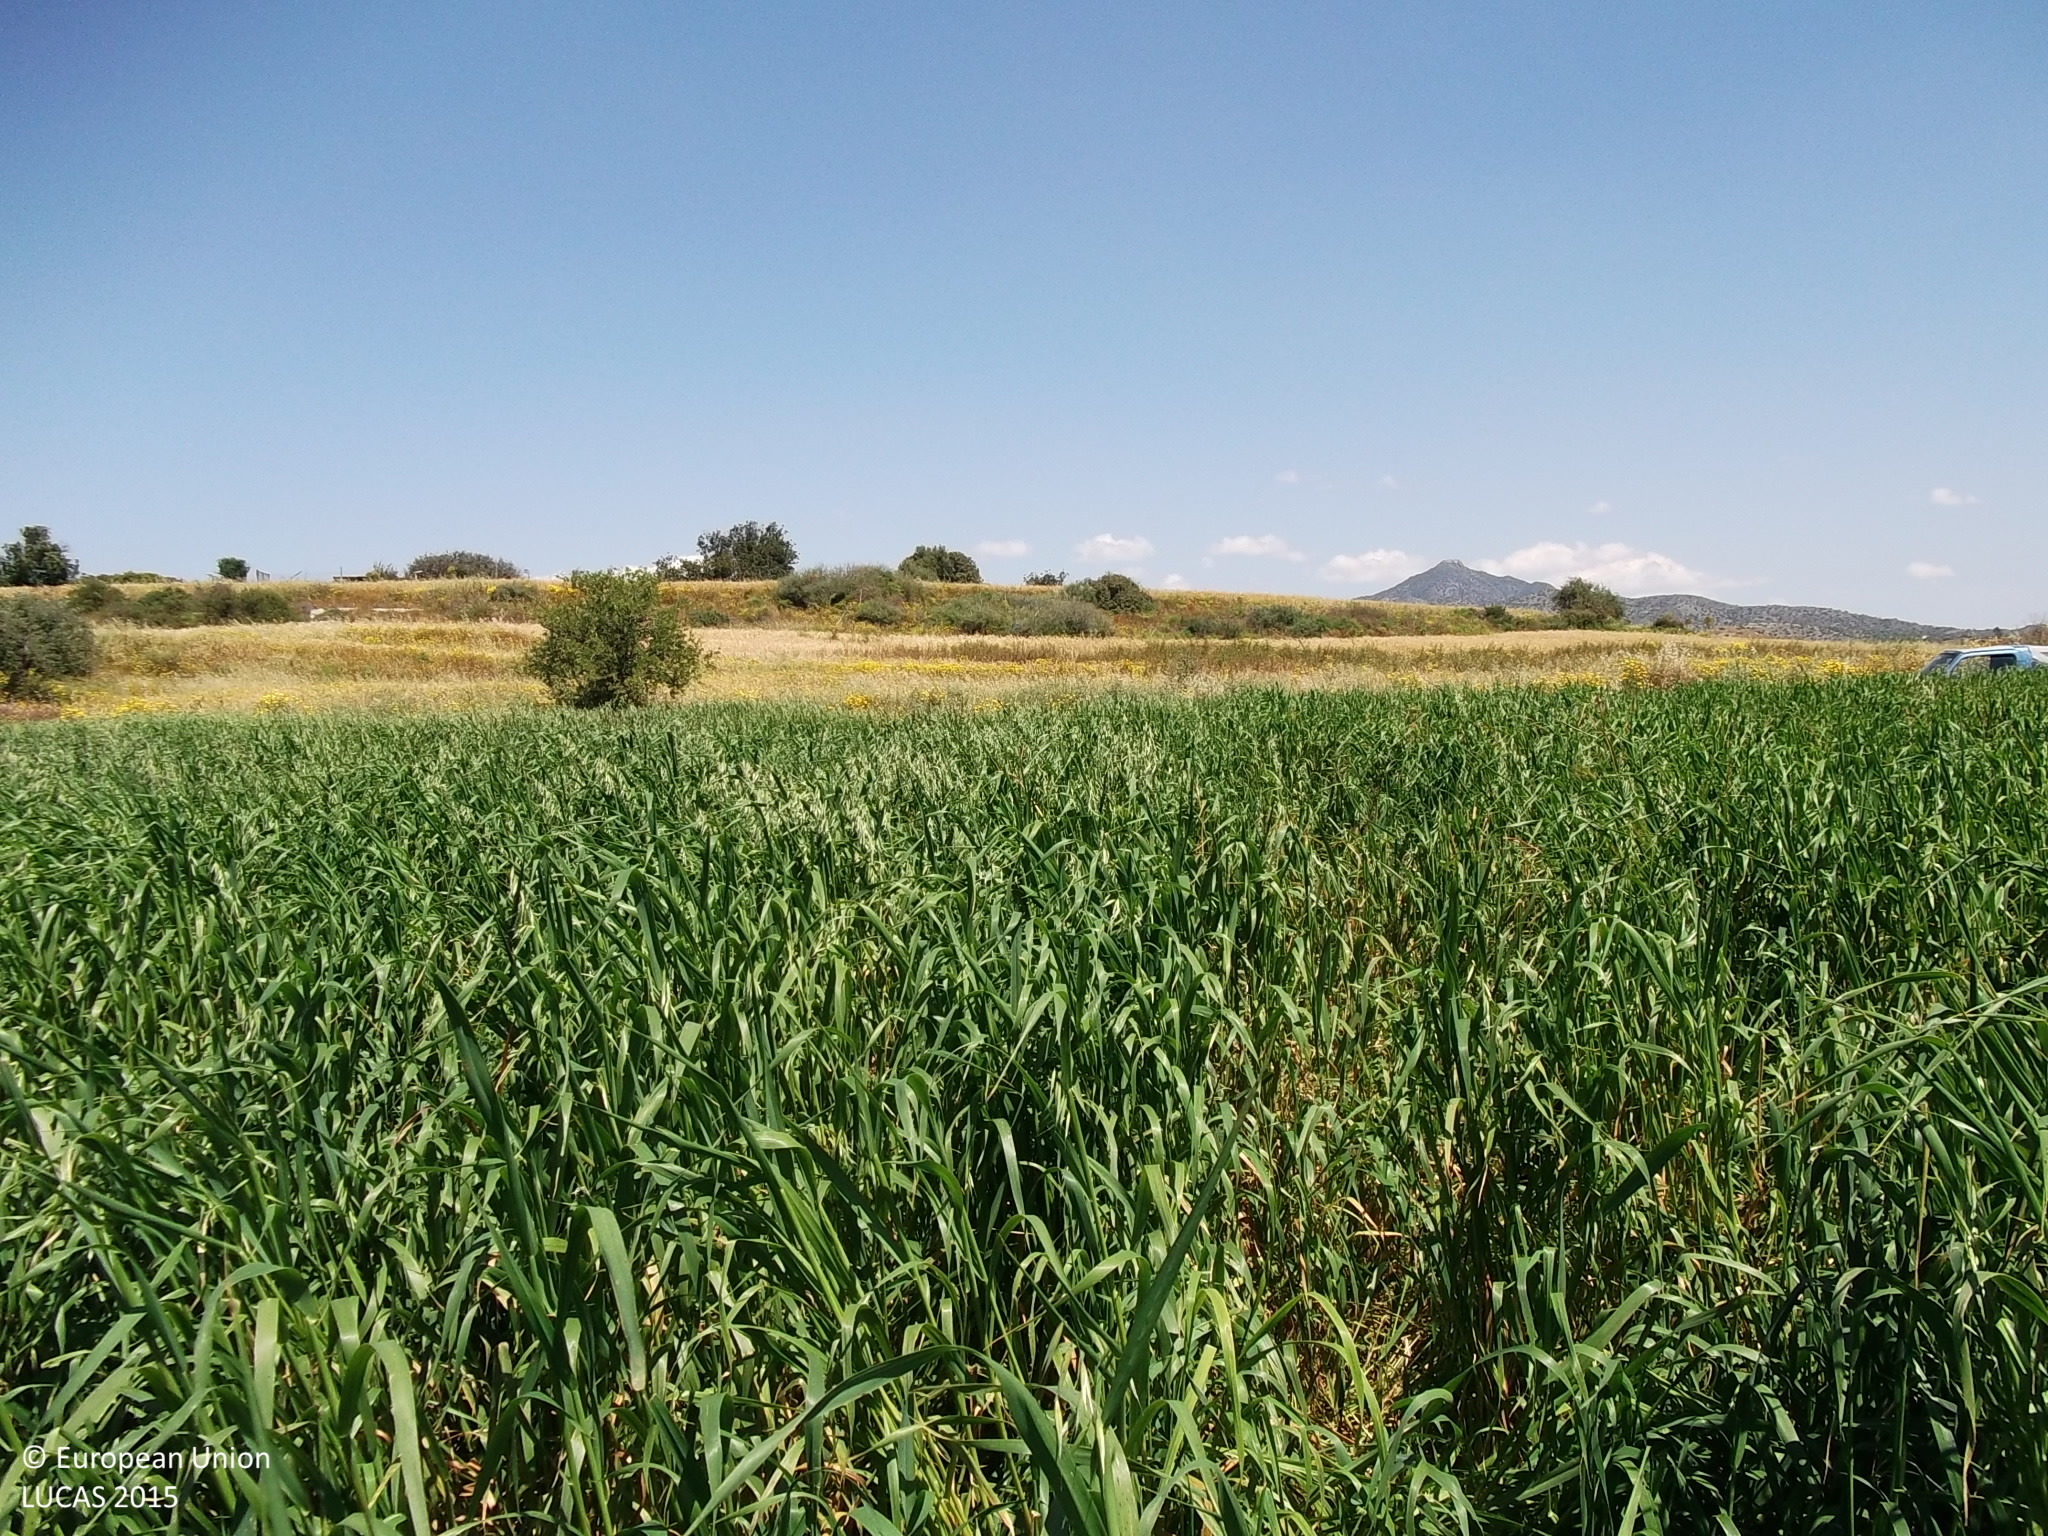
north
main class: Cropland
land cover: Oats
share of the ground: > 75 %
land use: Agriculture (excluding fallow land and kitchen gardens)
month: April
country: CY
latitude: 34.8179
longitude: 33.4160
